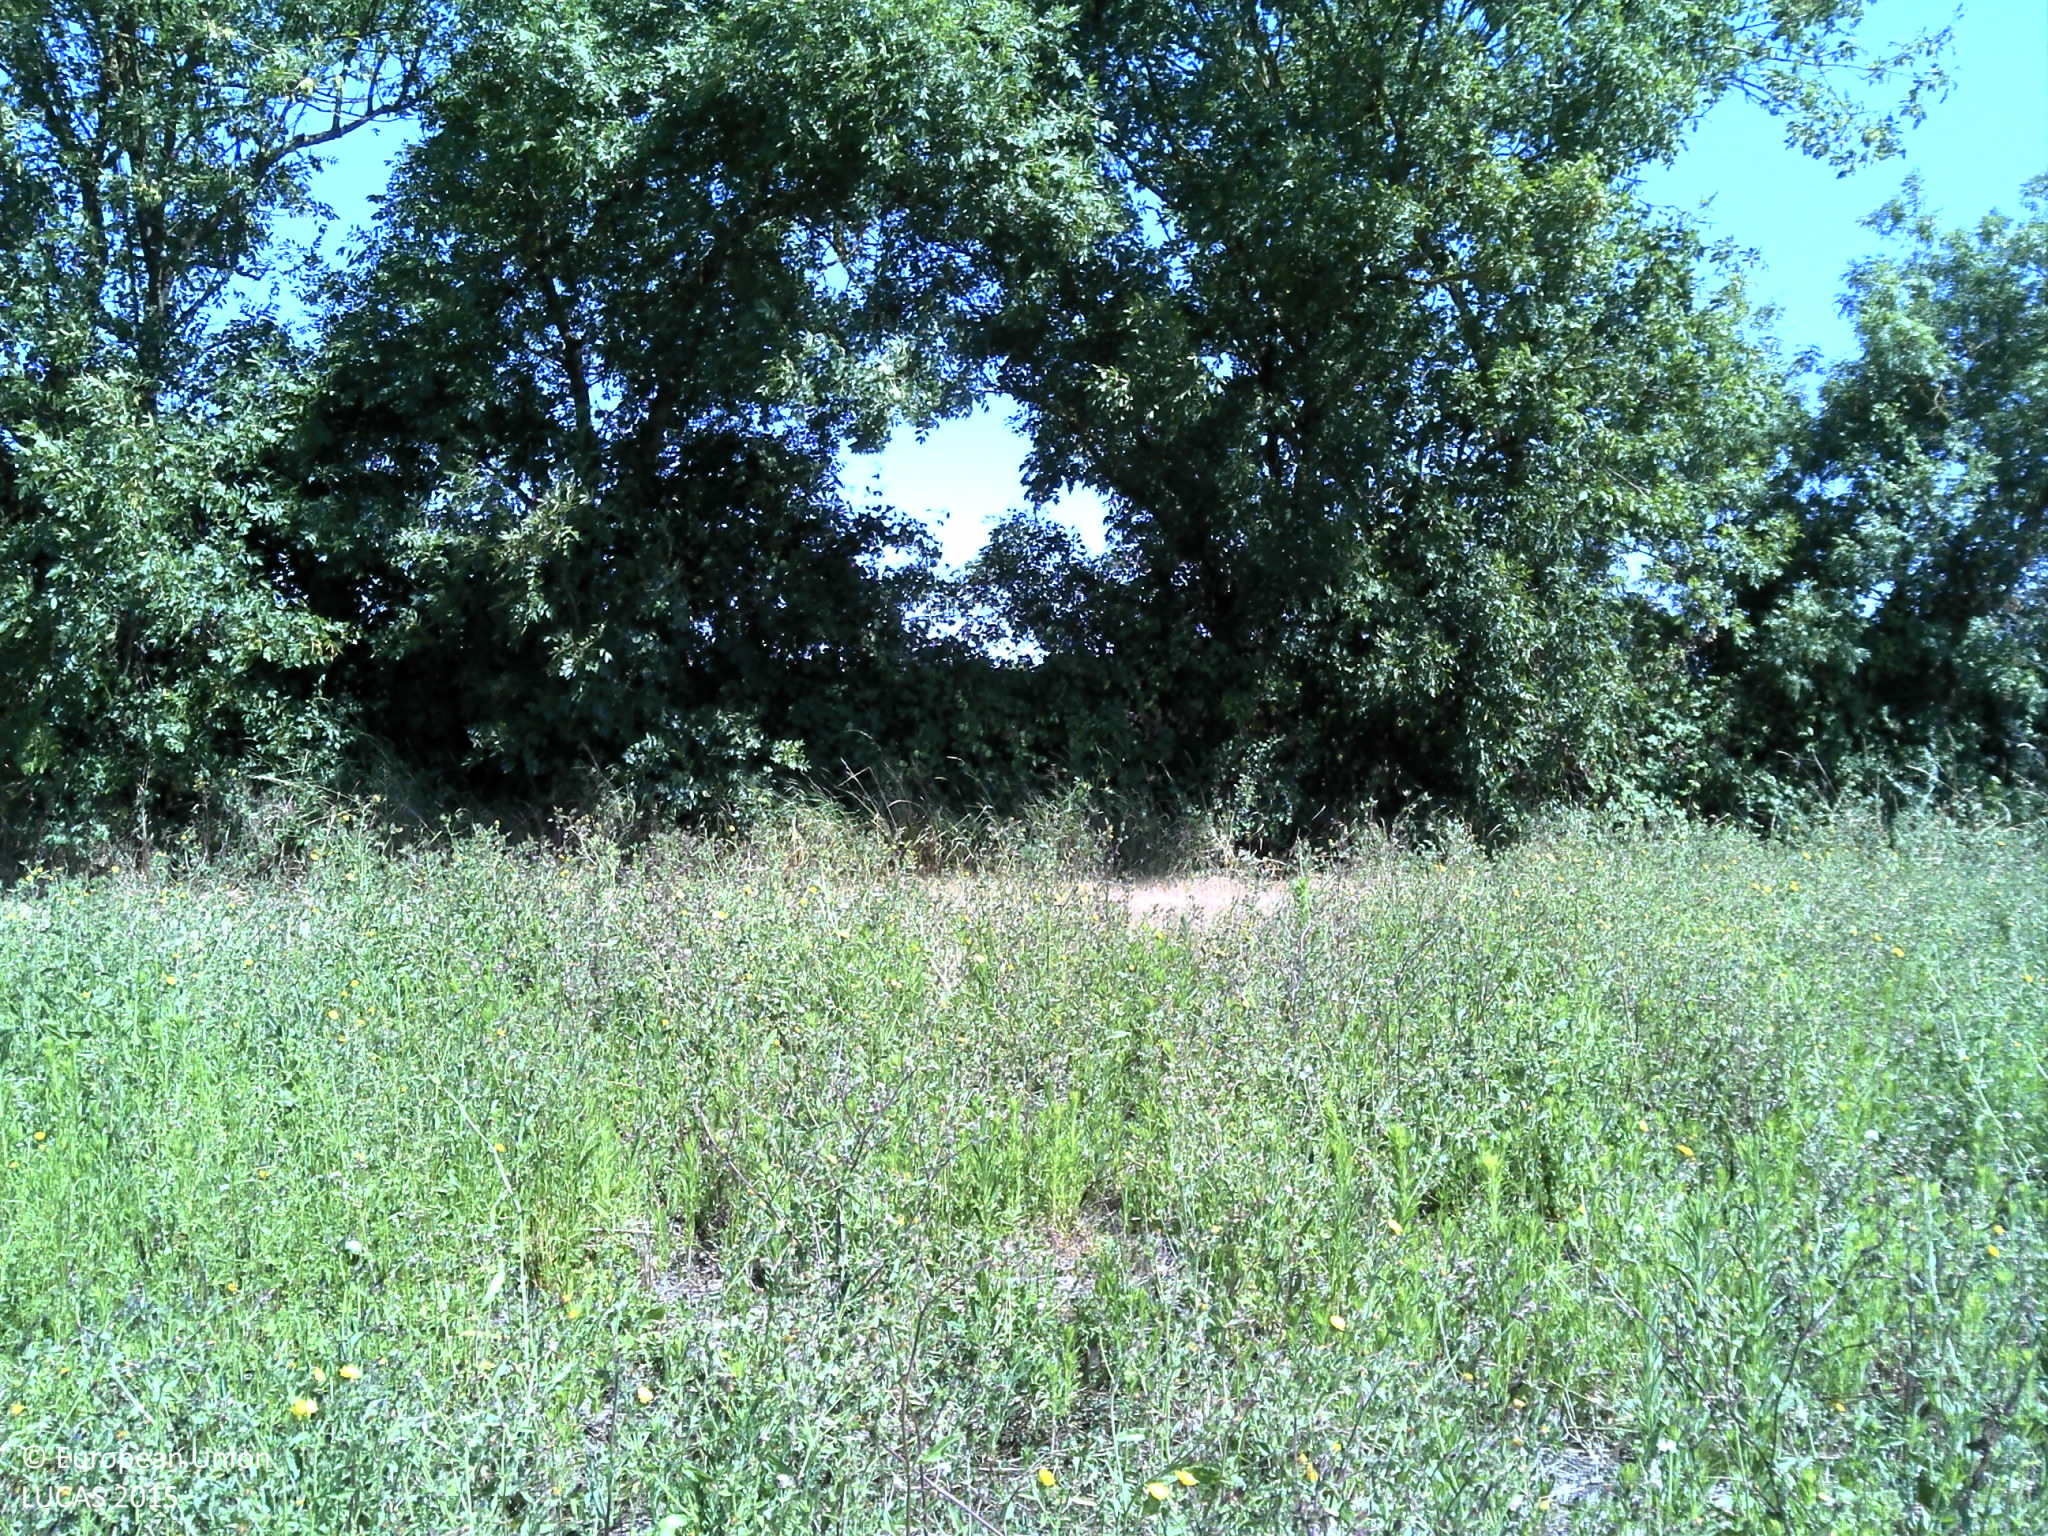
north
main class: Grassland
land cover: Spontaneously vegetated surfaces
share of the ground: > 75 %
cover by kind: herbaceous plants 100 %
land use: Fallow land
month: July
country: FR
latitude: 44.9762
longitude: -0.5311
